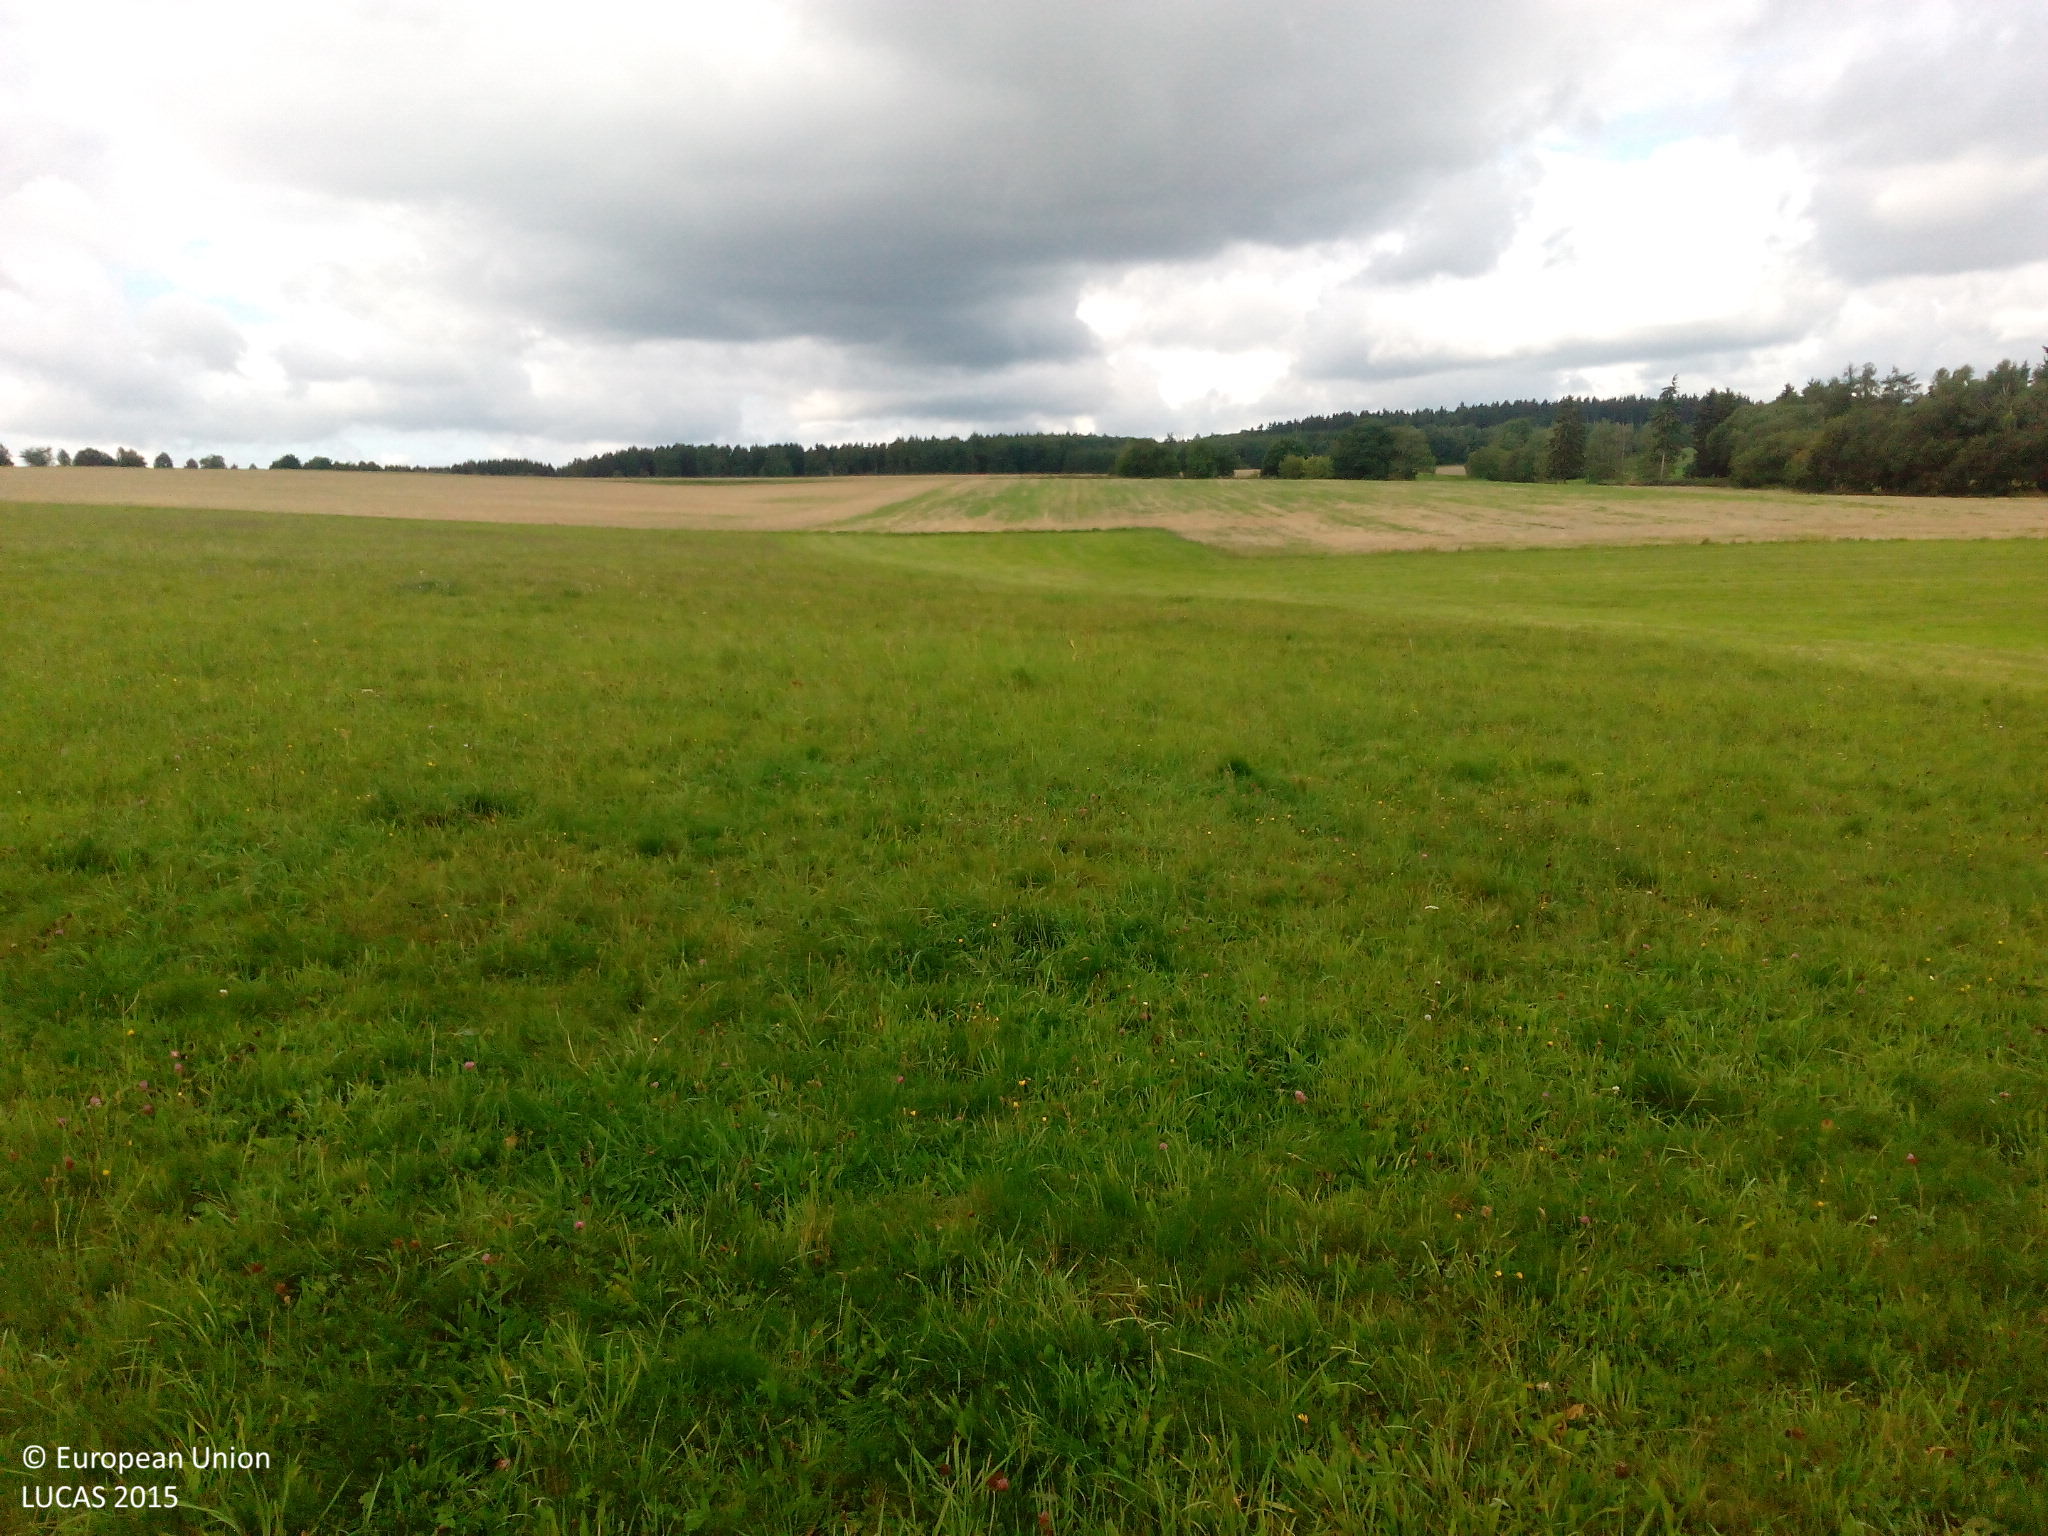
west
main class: Grassland
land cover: Grassland without tree/shrub cover
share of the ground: > 75 %
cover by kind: herbaceous plants 100 %
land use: Agriculture (excluding fallow land and kitchen gardens)
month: September
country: DE
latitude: 51.5993
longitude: 11.1113
